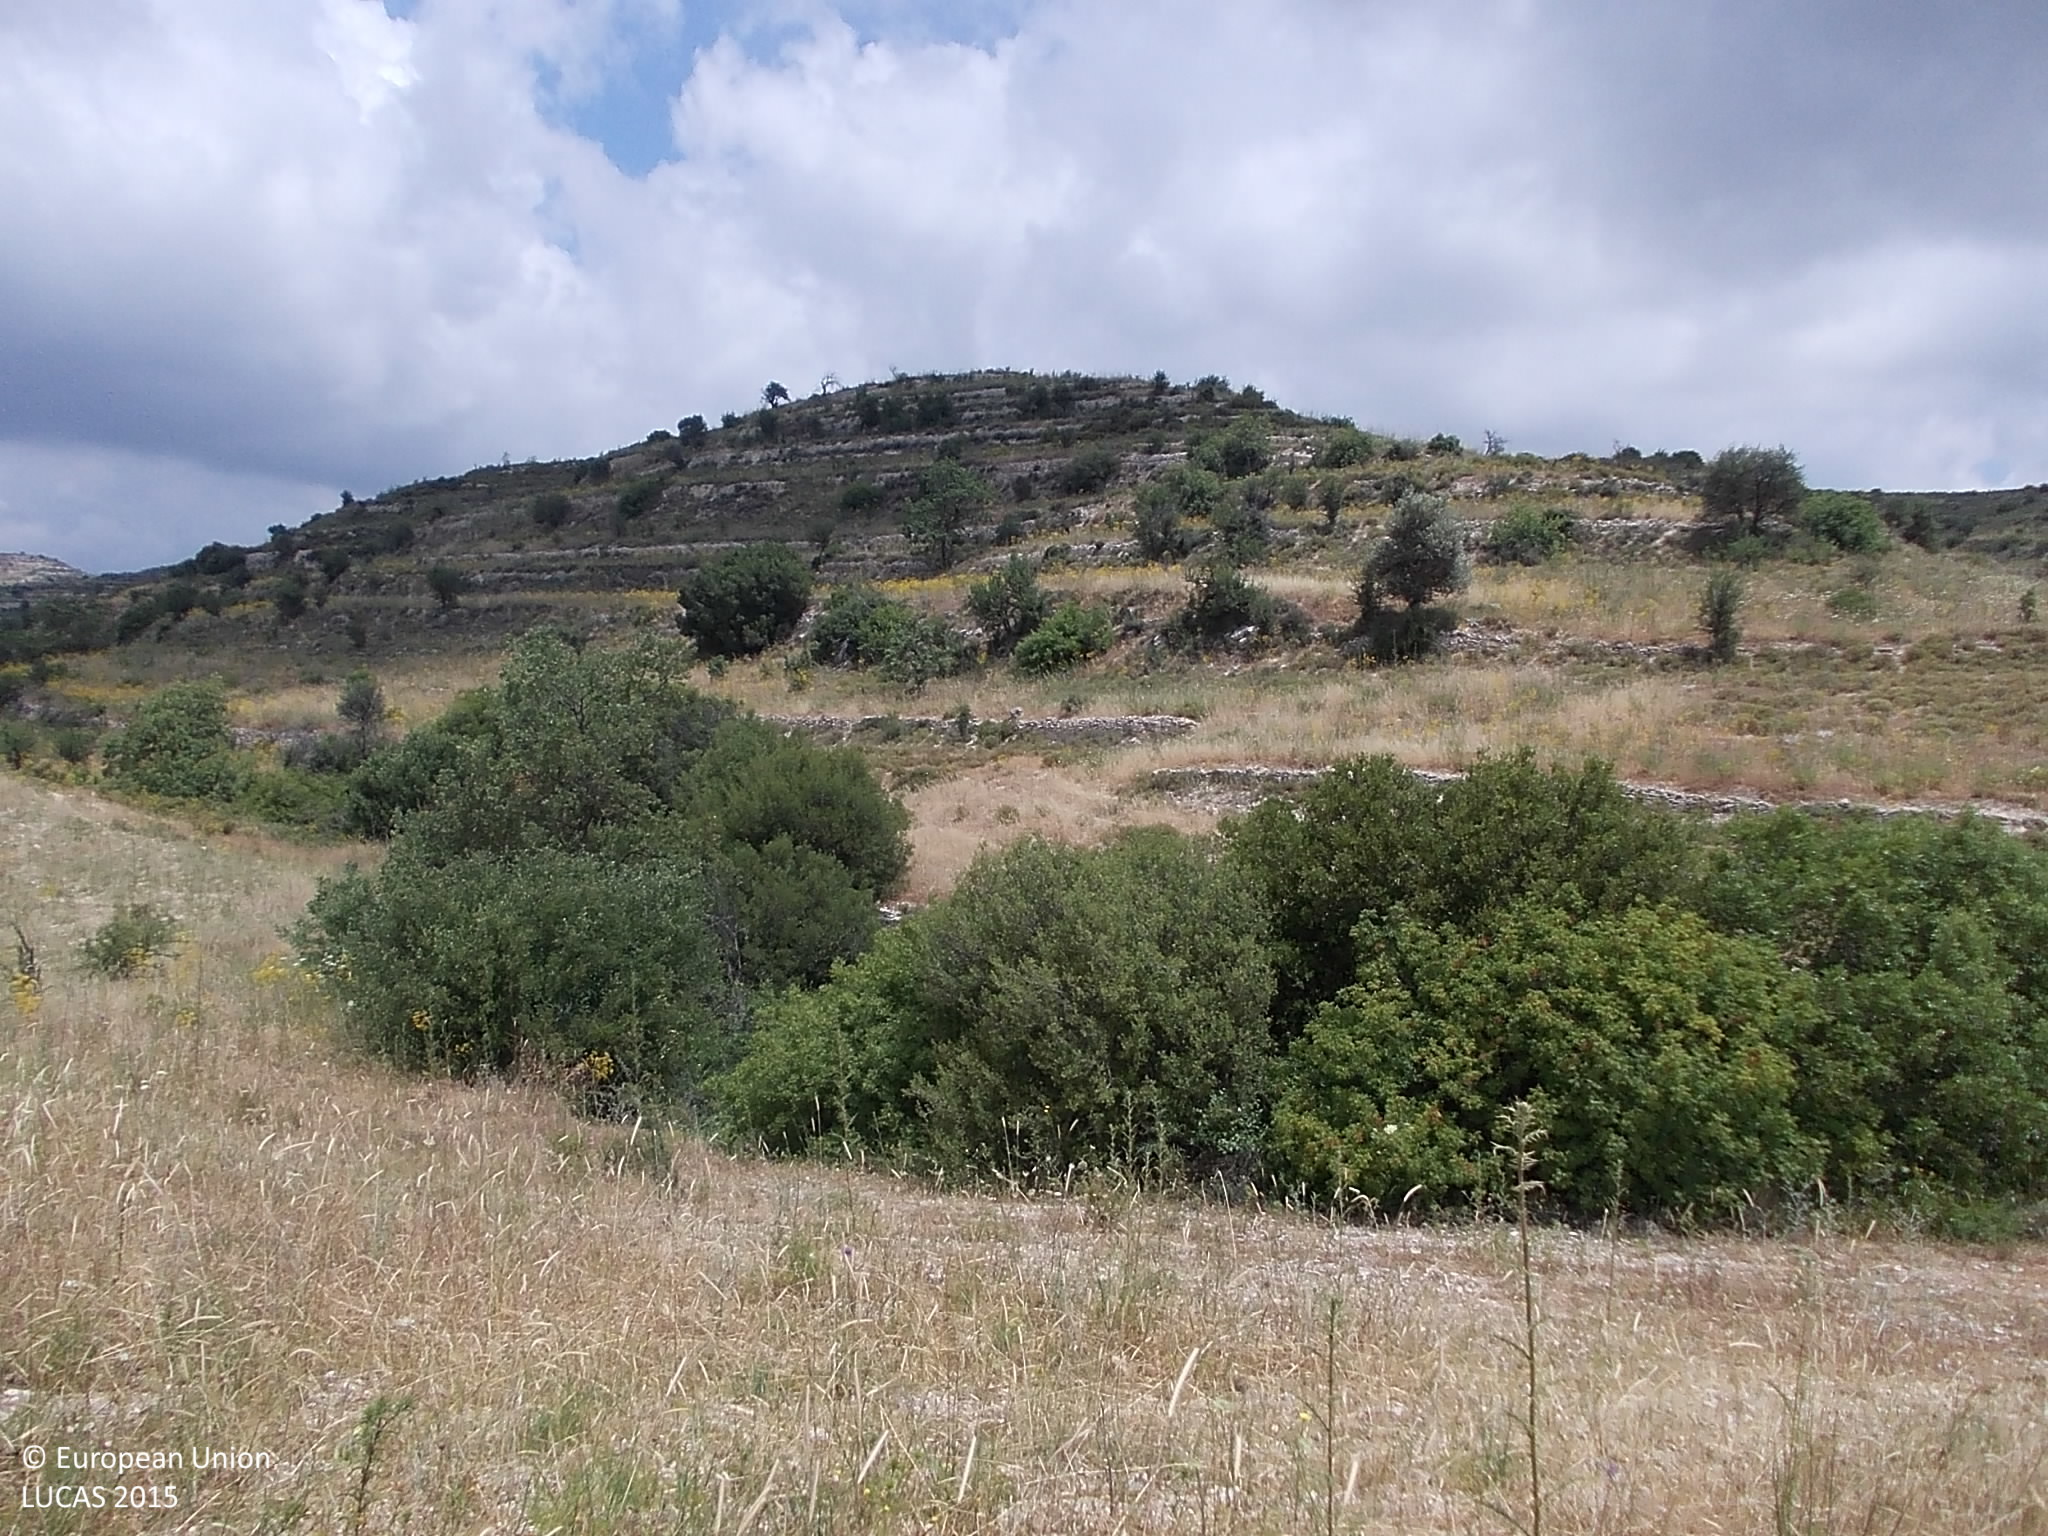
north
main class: Grassland
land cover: Spontaneously vegetated surfaces
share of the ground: > 75 %
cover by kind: herbaceous plants 90 %, shrubs 5 %, unconsolidated bare surface 5 %
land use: Fallow land
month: May
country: CY
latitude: 34.7852
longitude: 32.8138
